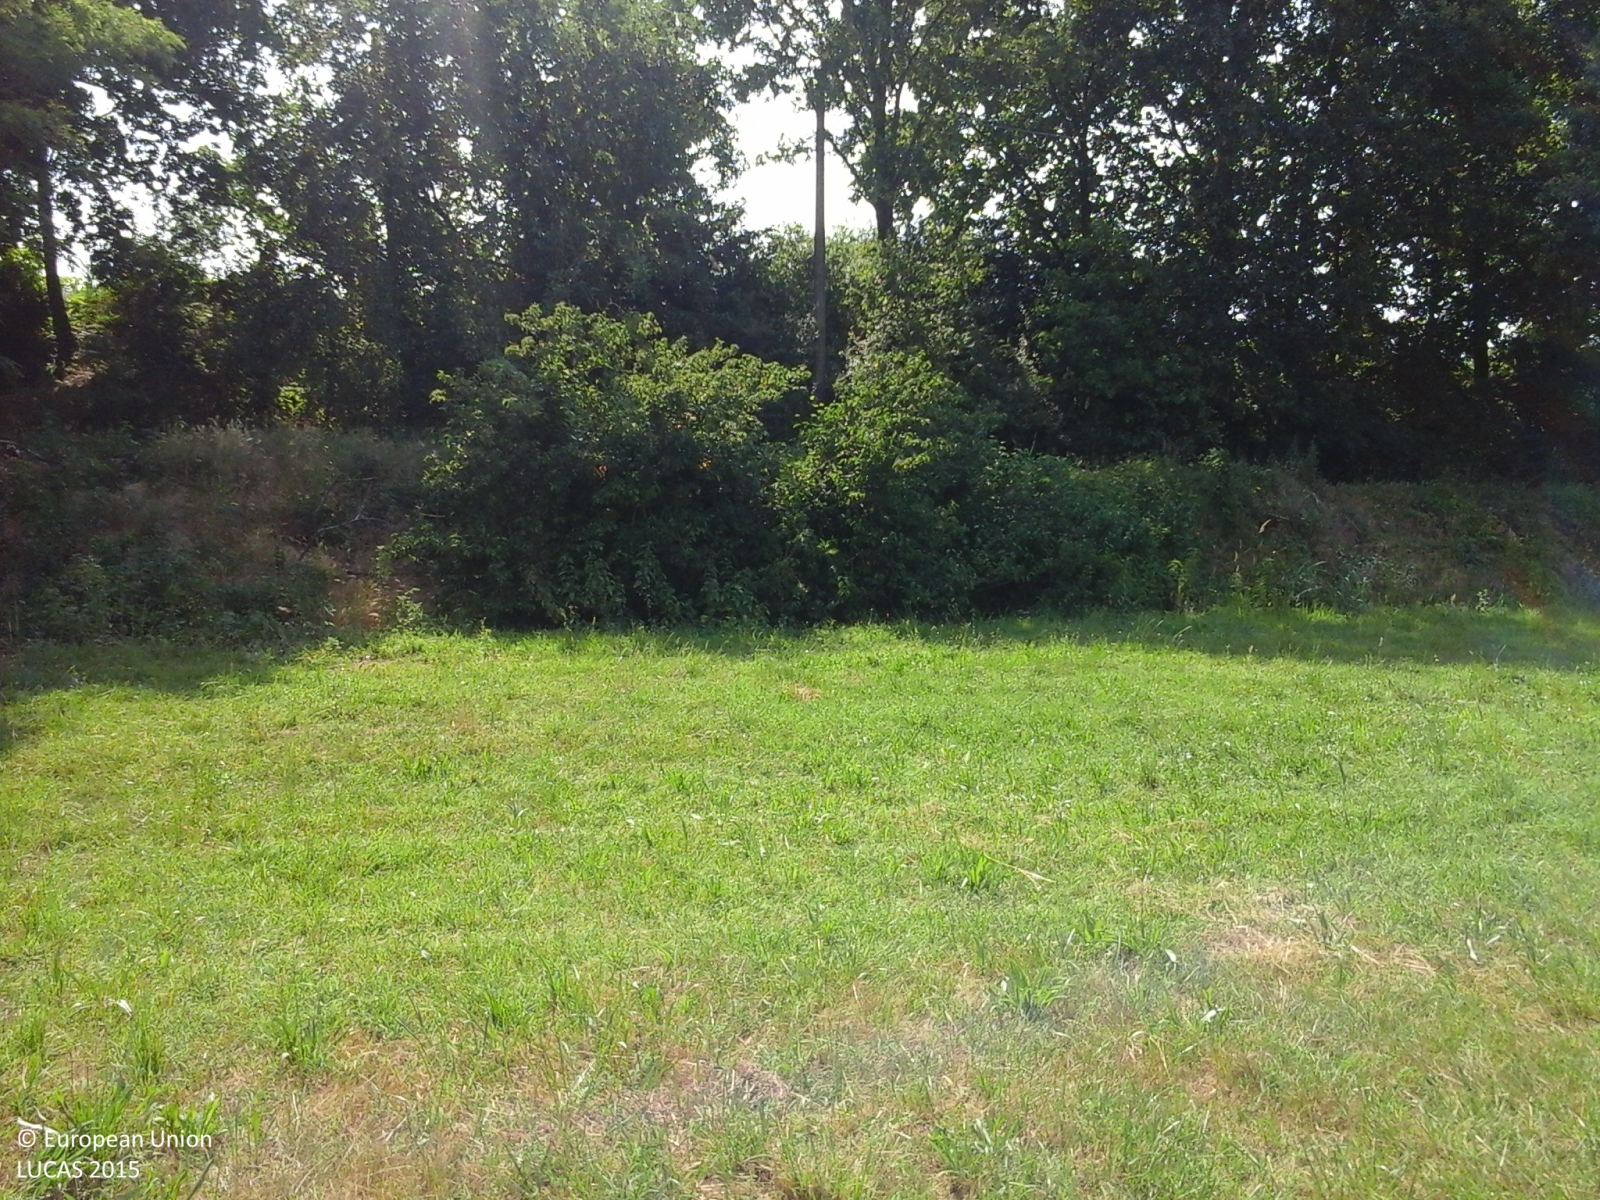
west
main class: Grassland
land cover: Grassland without tree/shrub cover
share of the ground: > 75 %
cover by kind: herbaceous plants 100 %
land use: Agriculture (excluding fallow land and kitchen gardens)
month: June
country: IT
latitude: 45.1614
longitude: 9.6572
